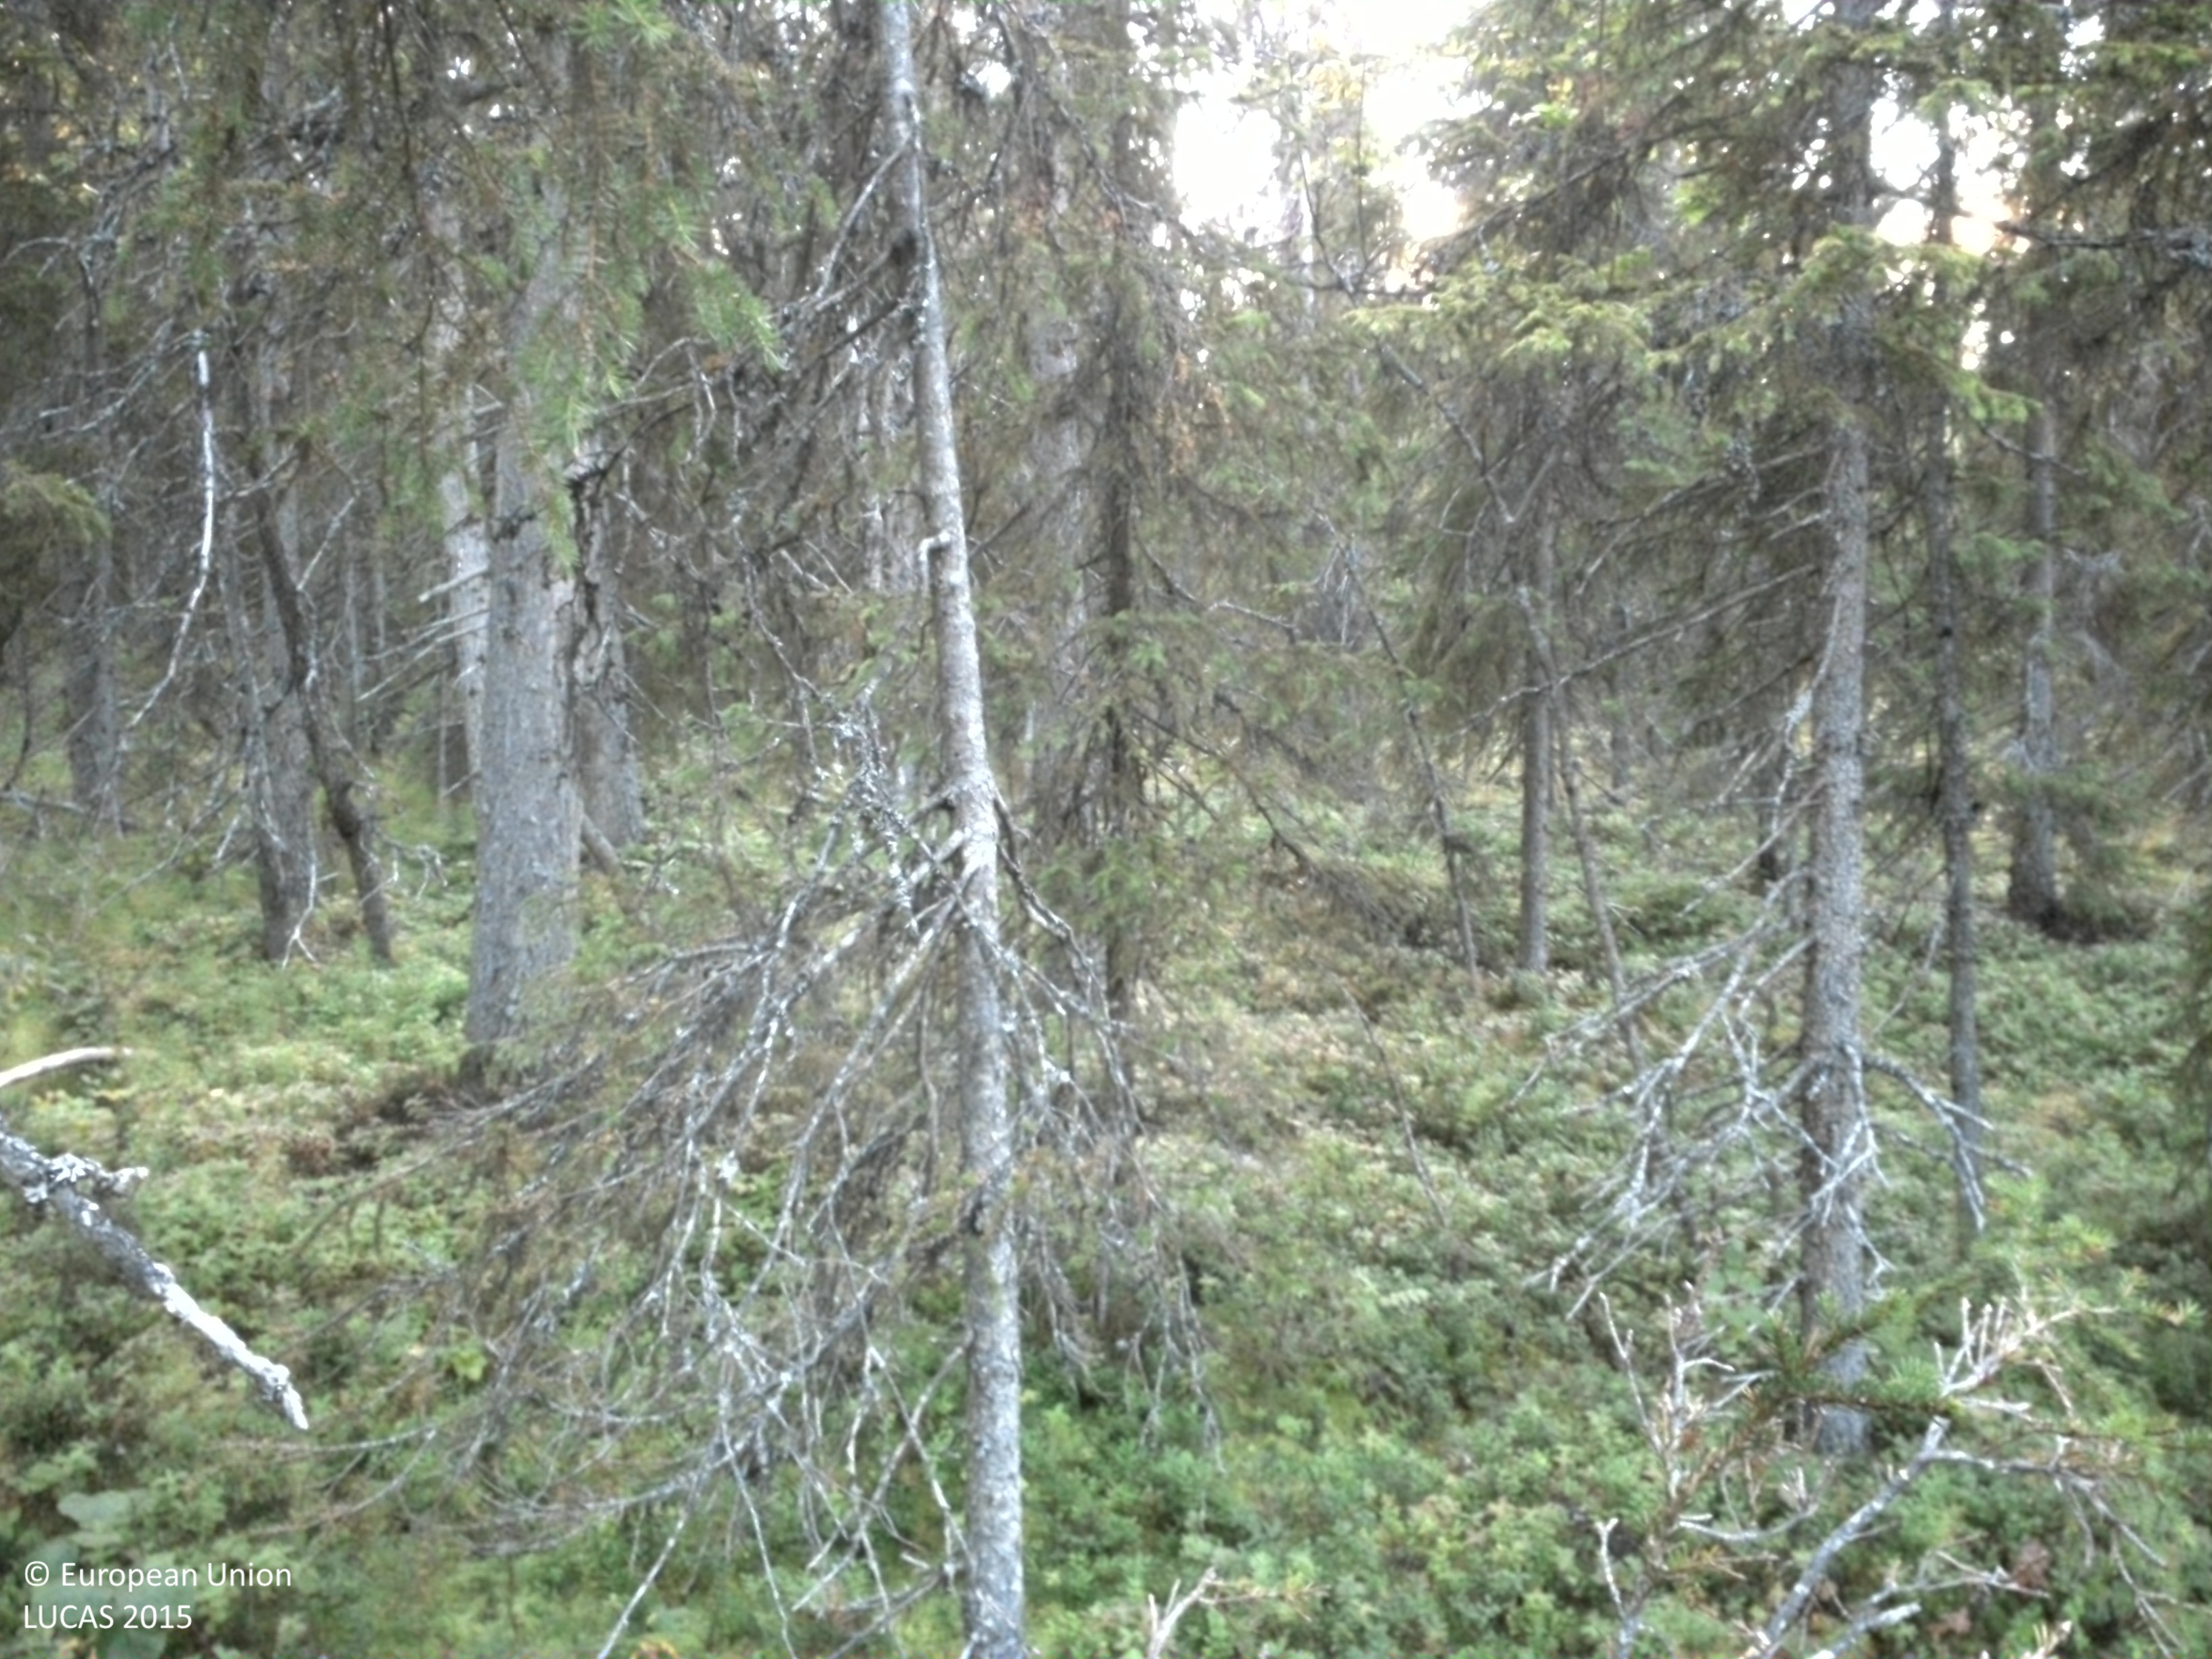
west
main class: Woodland
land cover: Spruce dominated coniferous woodland
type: boreal forest
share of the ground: 25 - 50 %
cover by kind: coniferous forest trees 30 %, shrubs 25 %, herbaceous plants 20 %, lichens and mosses 20 %, broadleaved forest trees 5 %
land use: Amenities, museums, leisure
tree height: > 5 m
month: September
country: SE
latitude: 65.7267
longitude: 16.2174
